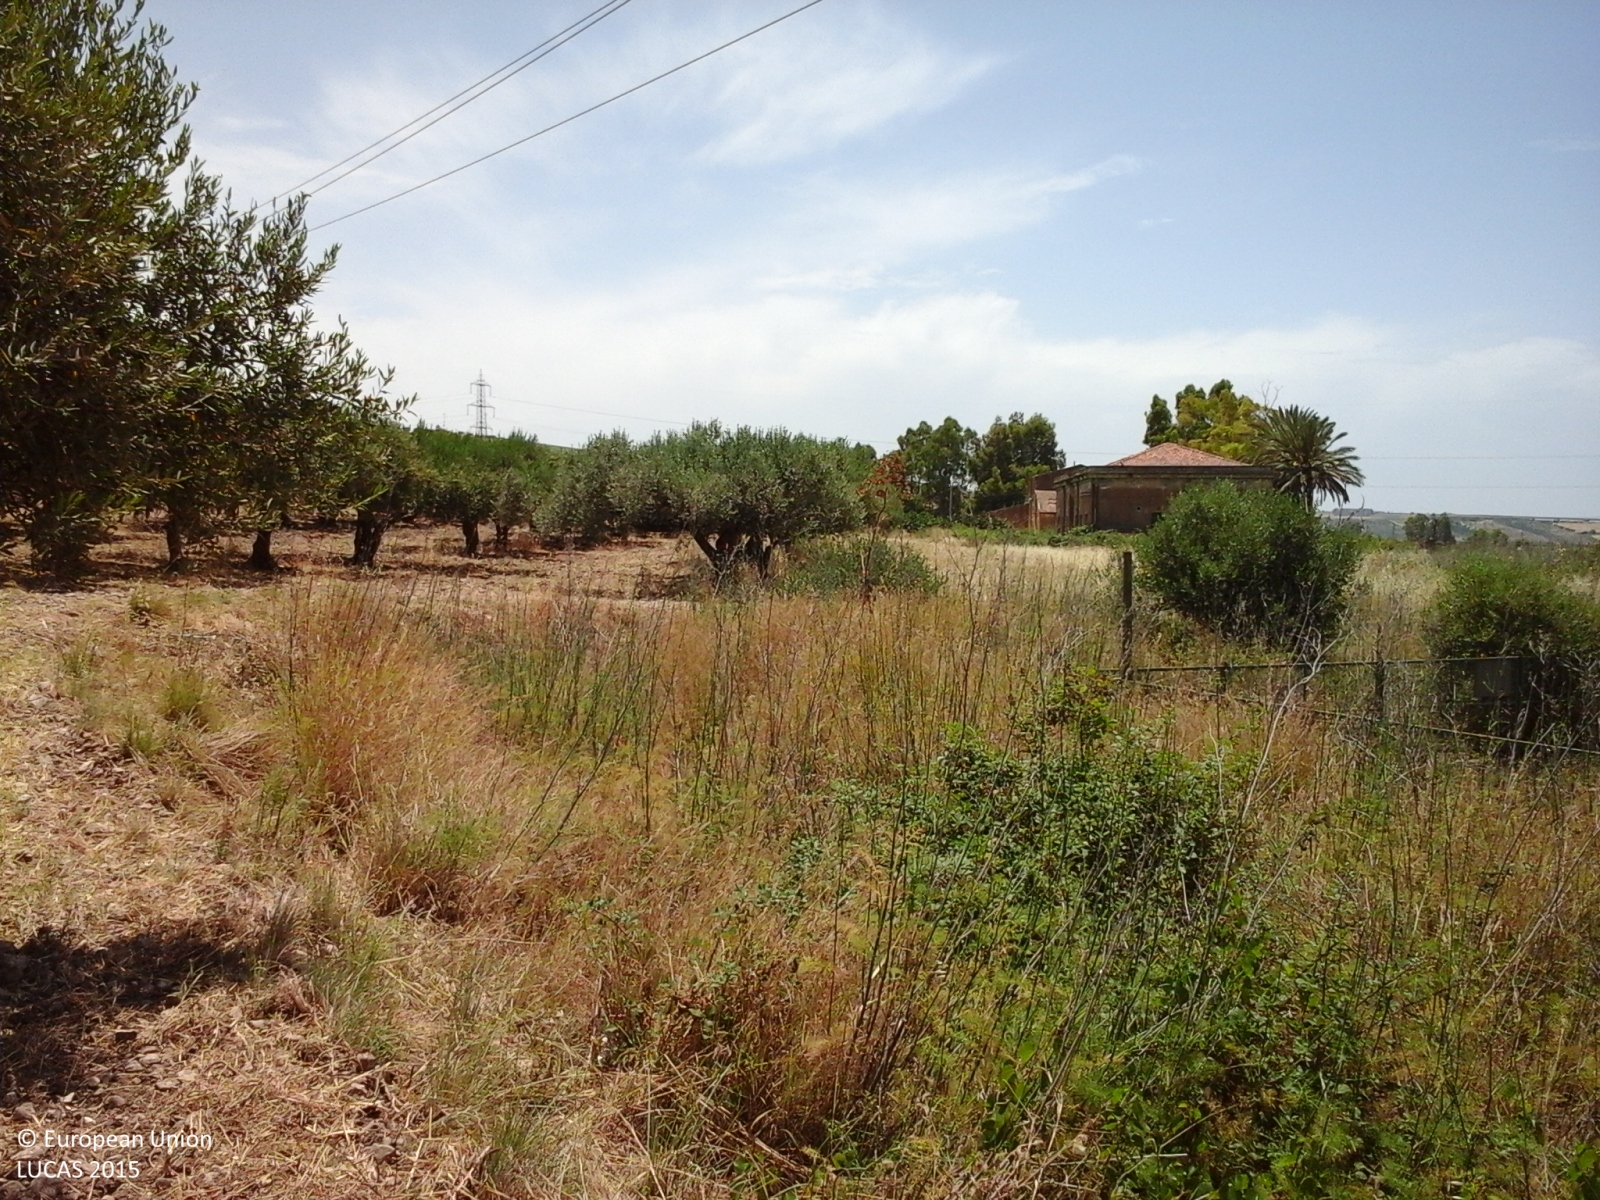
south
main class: Cropland
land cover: Olive groves
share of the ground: 50 - 75 %
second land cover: Other bare soil
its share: > 75 %
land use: Agriculture (excluding fallow land and kitchen gardens)
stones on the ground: 10 - 25 %
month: June
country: IT
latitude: 37.6079
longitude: 13.0467
